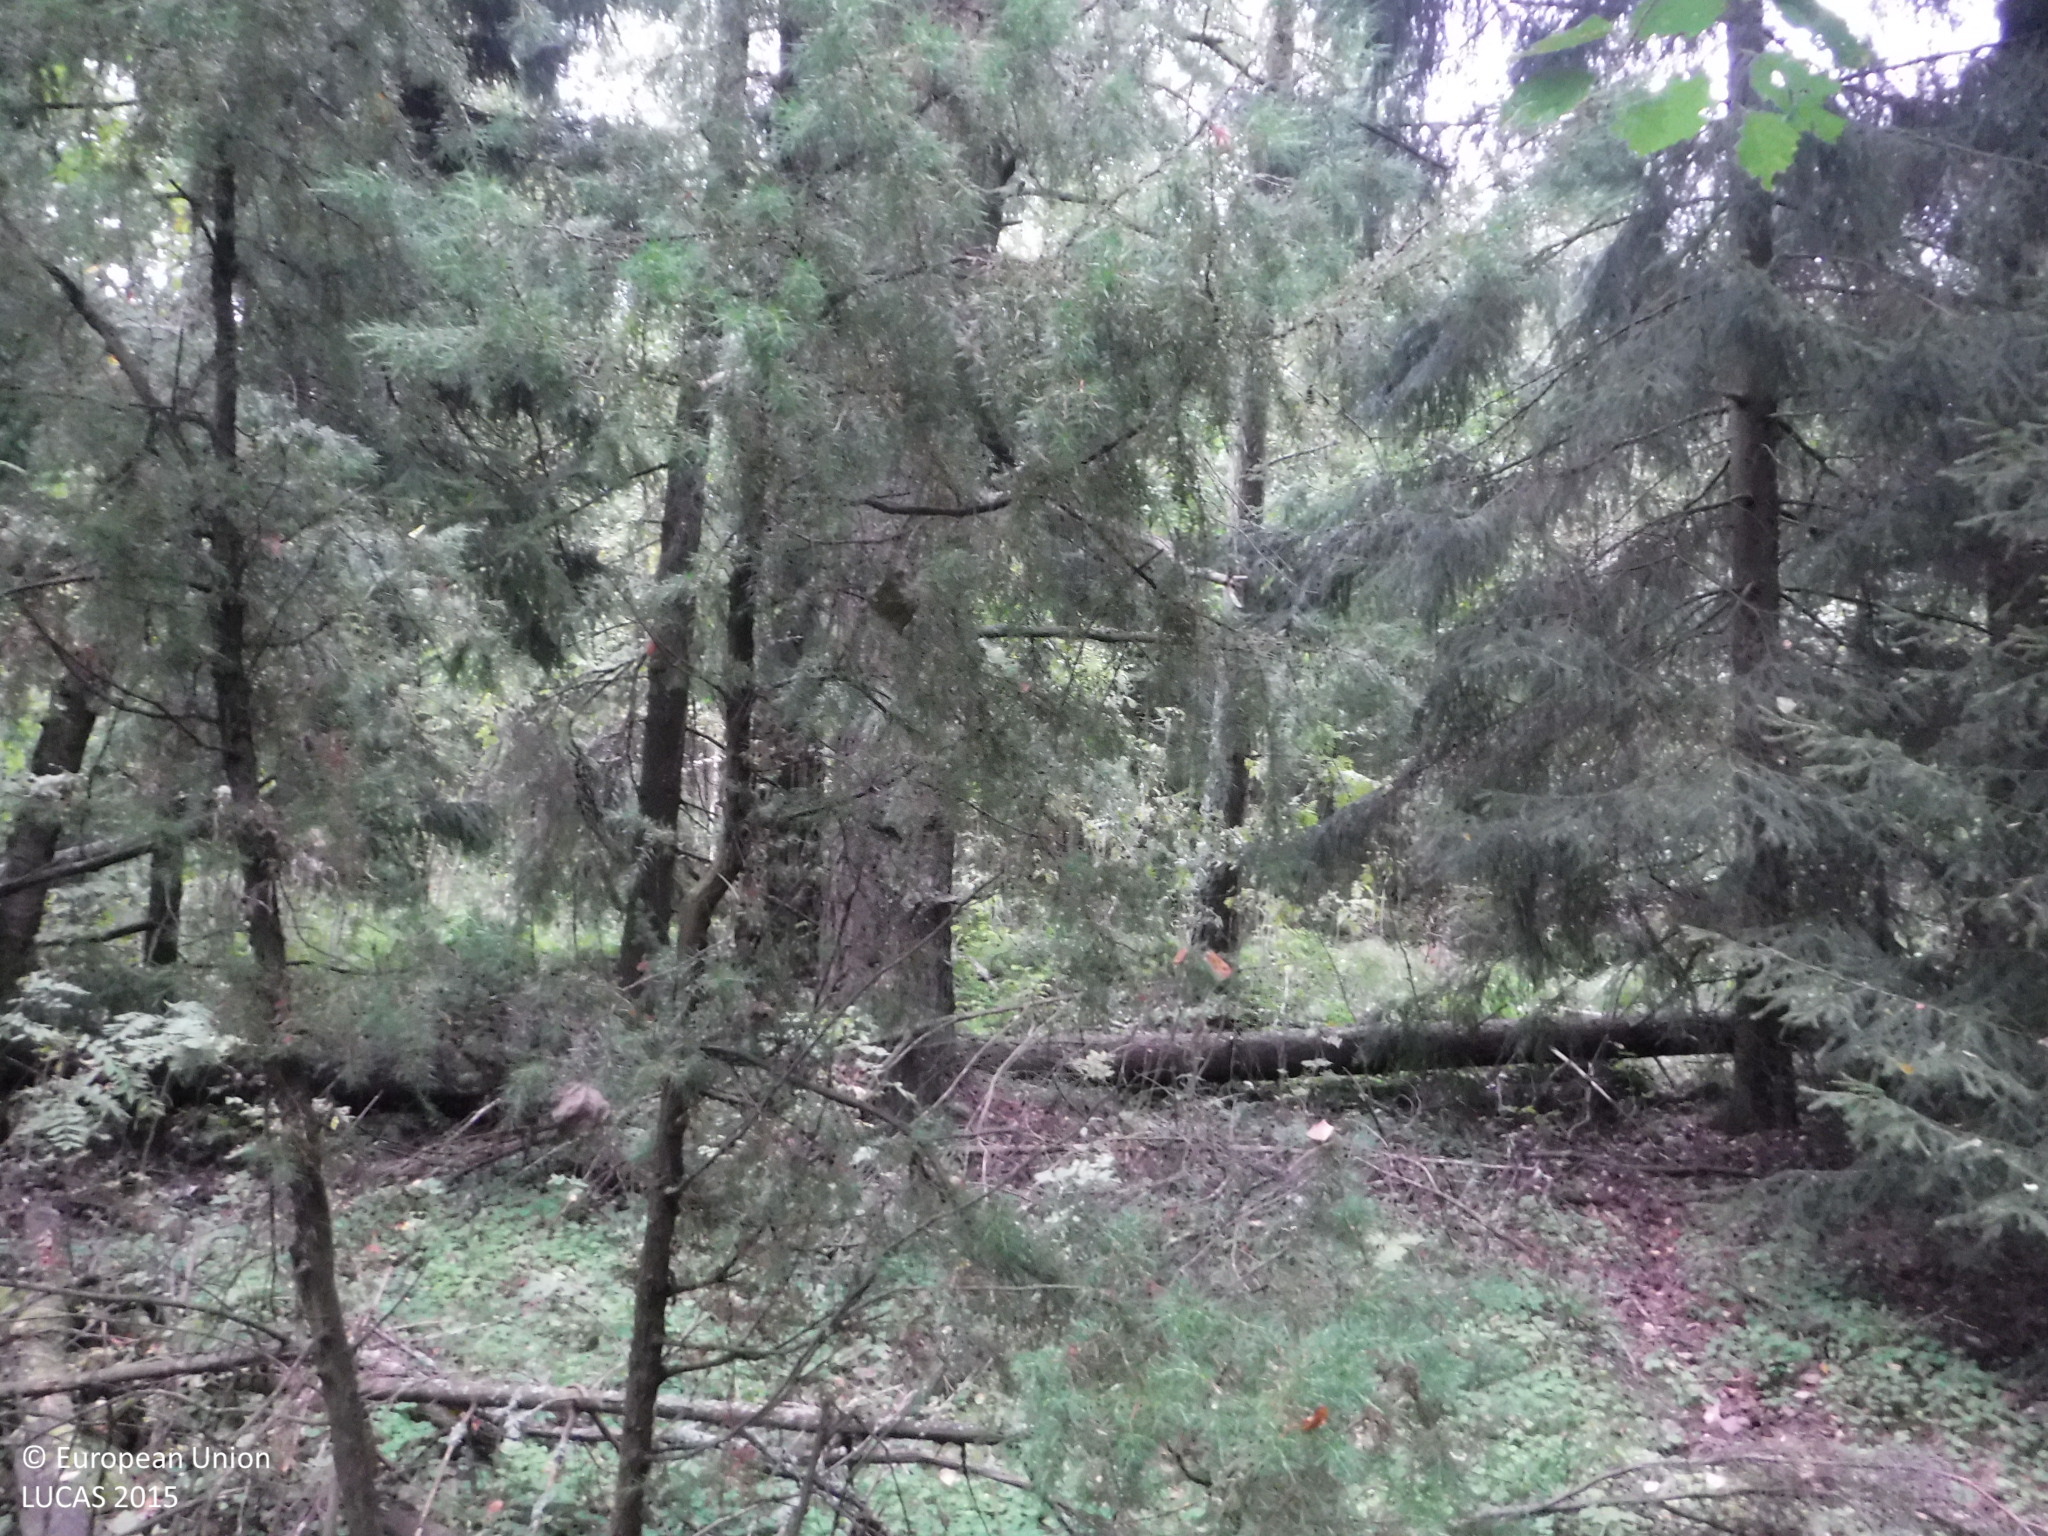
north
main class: Woodland
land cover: Other mixed woodland
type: boreal forest
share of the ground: > 75 %
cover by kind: broadleaved forest trees 40 %, coniferous forest trees 35 %, herbaceous plants 10 %, unconsolidated bare surface 10 %, shrubs 5 %
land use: Semi-natural and natural areas not in use
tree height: > 5 m
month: September
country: FI
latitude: 61.3418
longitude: 22.0397
